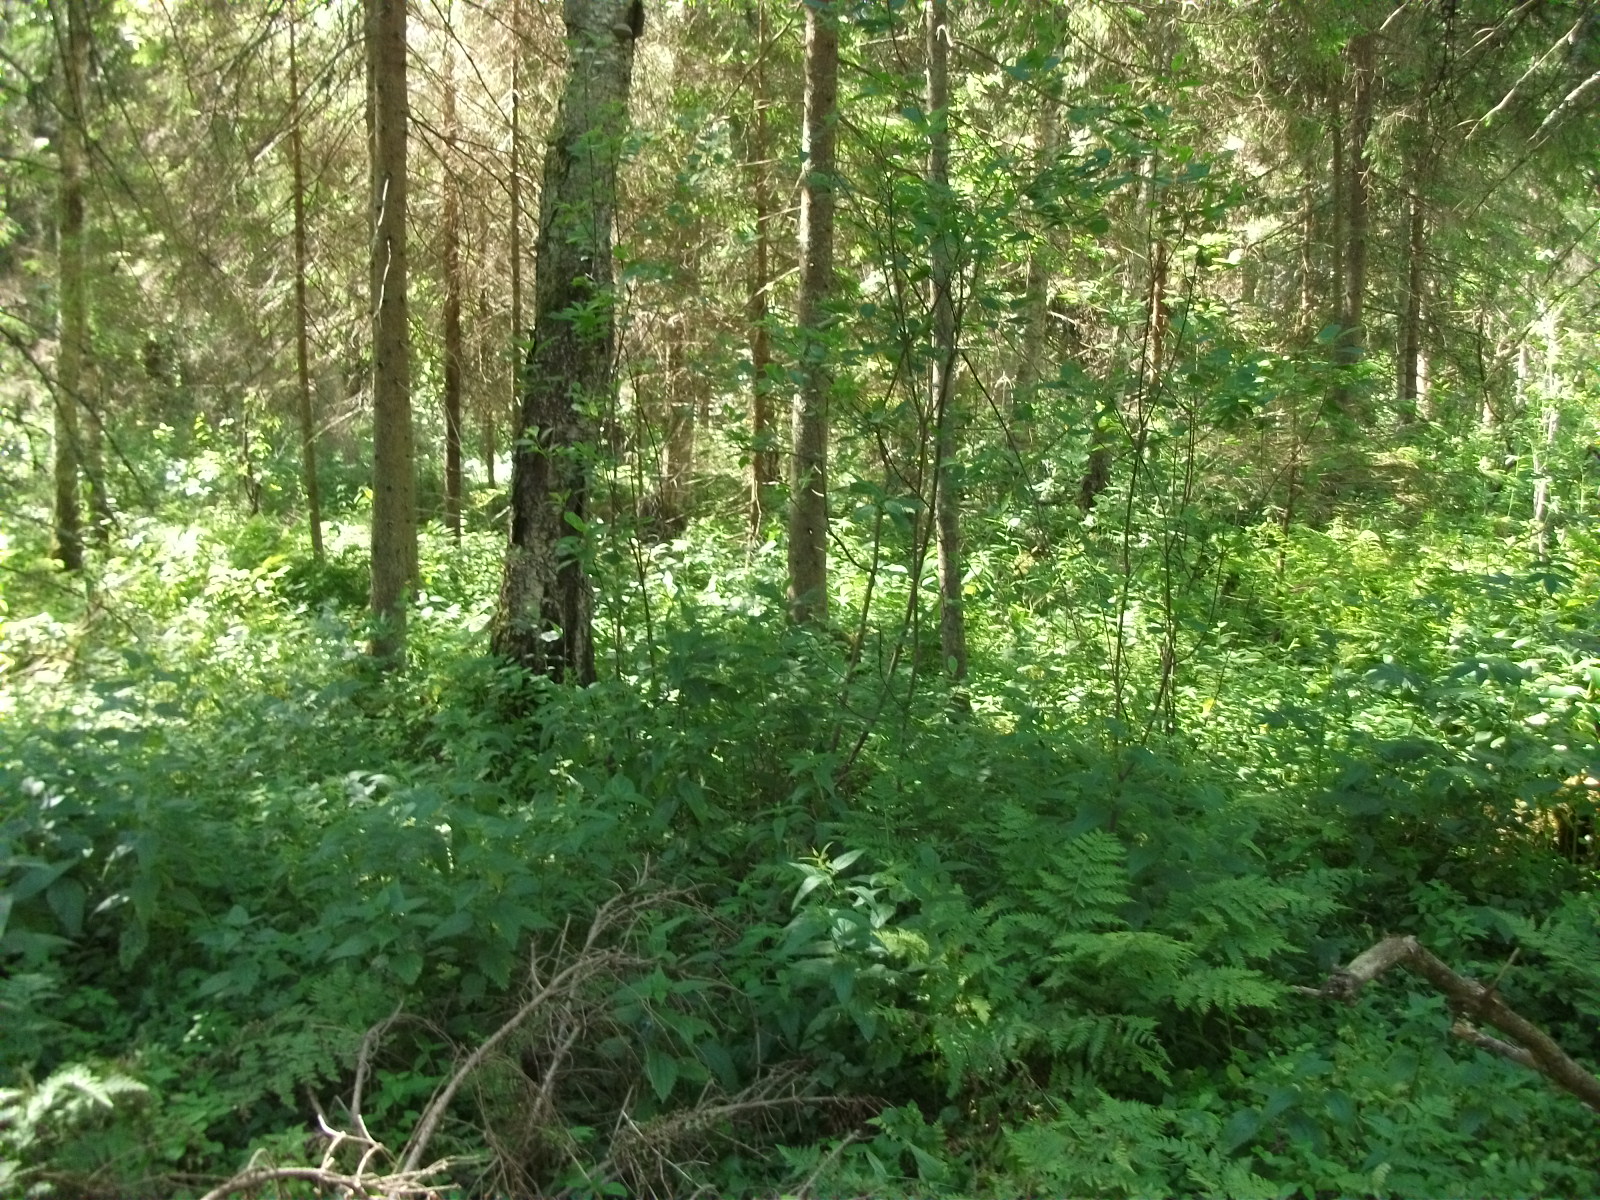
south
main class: Woodland
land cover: Spruce dominated coniferous woodland
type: hemiboreal forest and nemoral coniferous forest and mixed broadleaved-coniferous forest
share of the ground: > 75 %
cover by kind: coniferous forest trees 75 %, broadleaved forest trees 10 %, shrubs 10 %, herbaceous plants 5 %
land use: Forestry
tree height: > 5 m
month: July
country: LV
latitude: 56.7545
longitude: 26.1481
